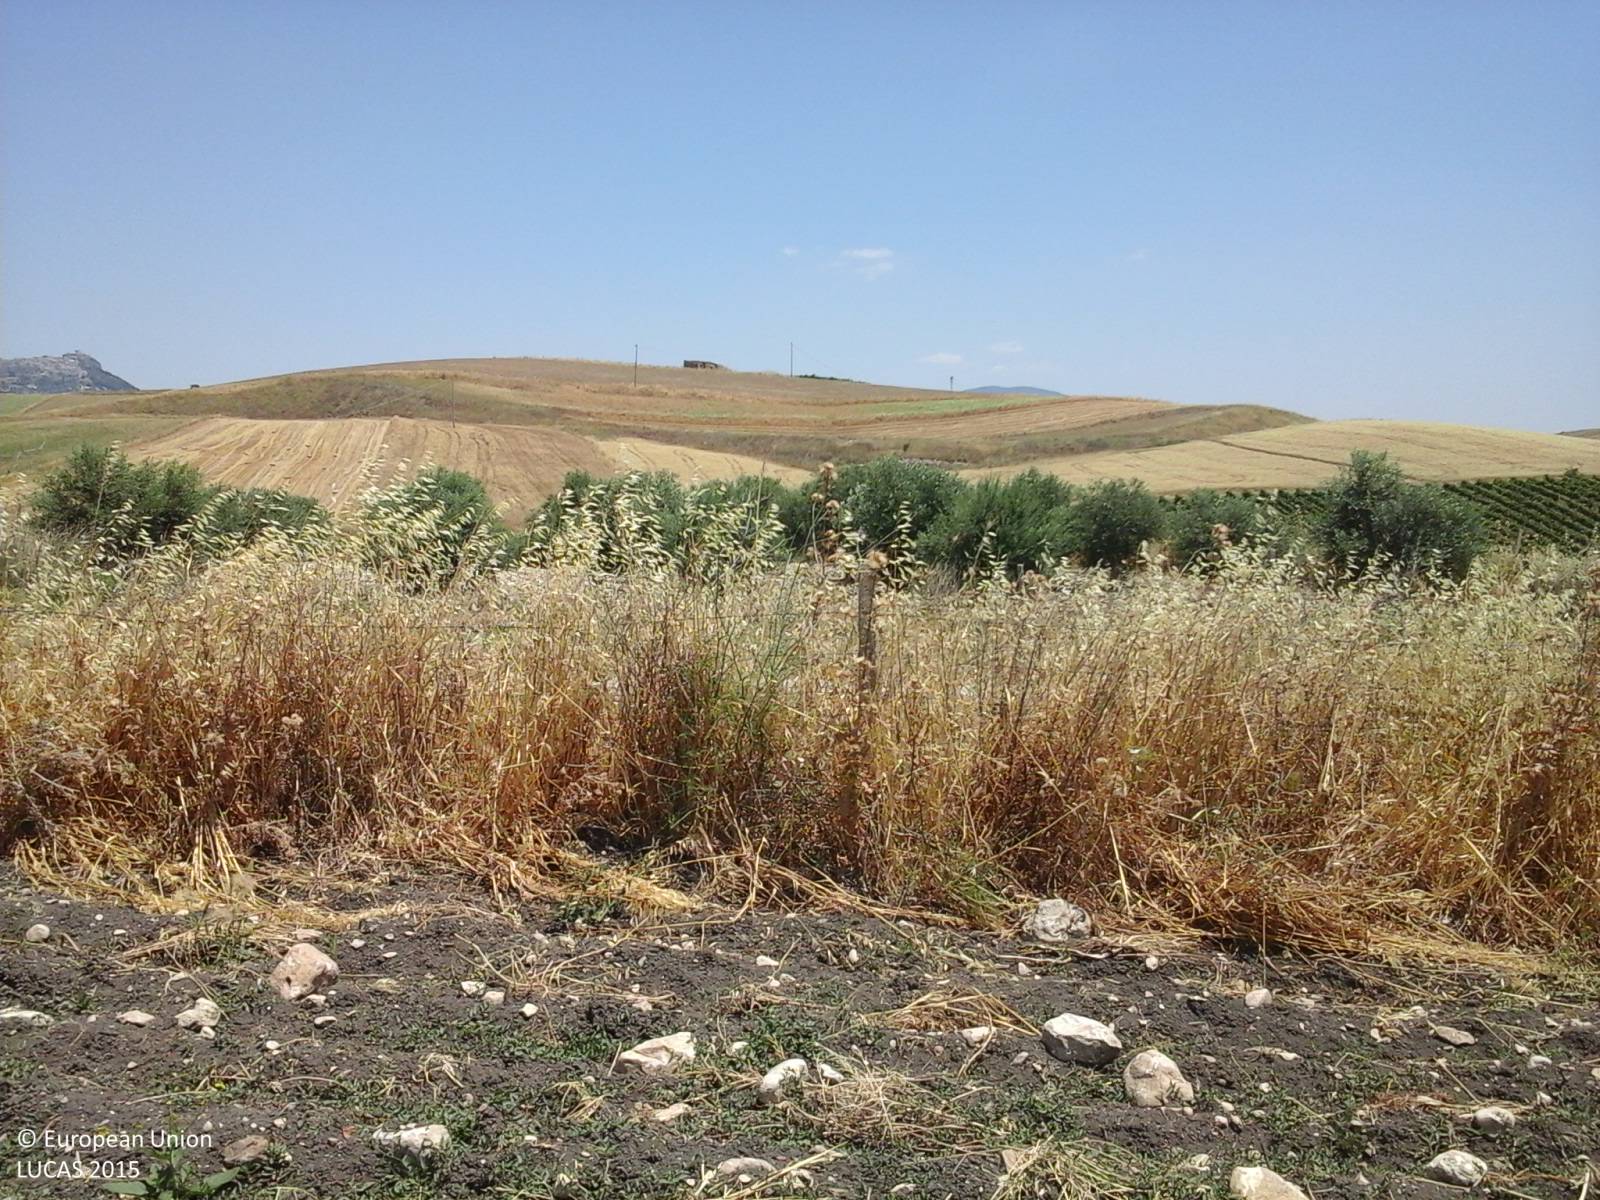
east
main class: Cropland
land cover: Olive groves
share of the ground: 10 - 25 %
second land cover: Other bare soil
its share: > 75 %
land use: Agriculture (excluding fallow land and kitchen gardens)
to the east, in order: Olive groves; Other bare soil; Grass margins; Fences; Paved roads, cycling and walking lanes; Grass margins; Fences; Olive groves; Shrubland with sparse tree cover; Inland fresh running water; Shrubland with sparse tree cover; Durum wheat; Ditches and canals; Durum wheat
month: July
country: IT
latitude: 37.6579
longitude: 13.1840
